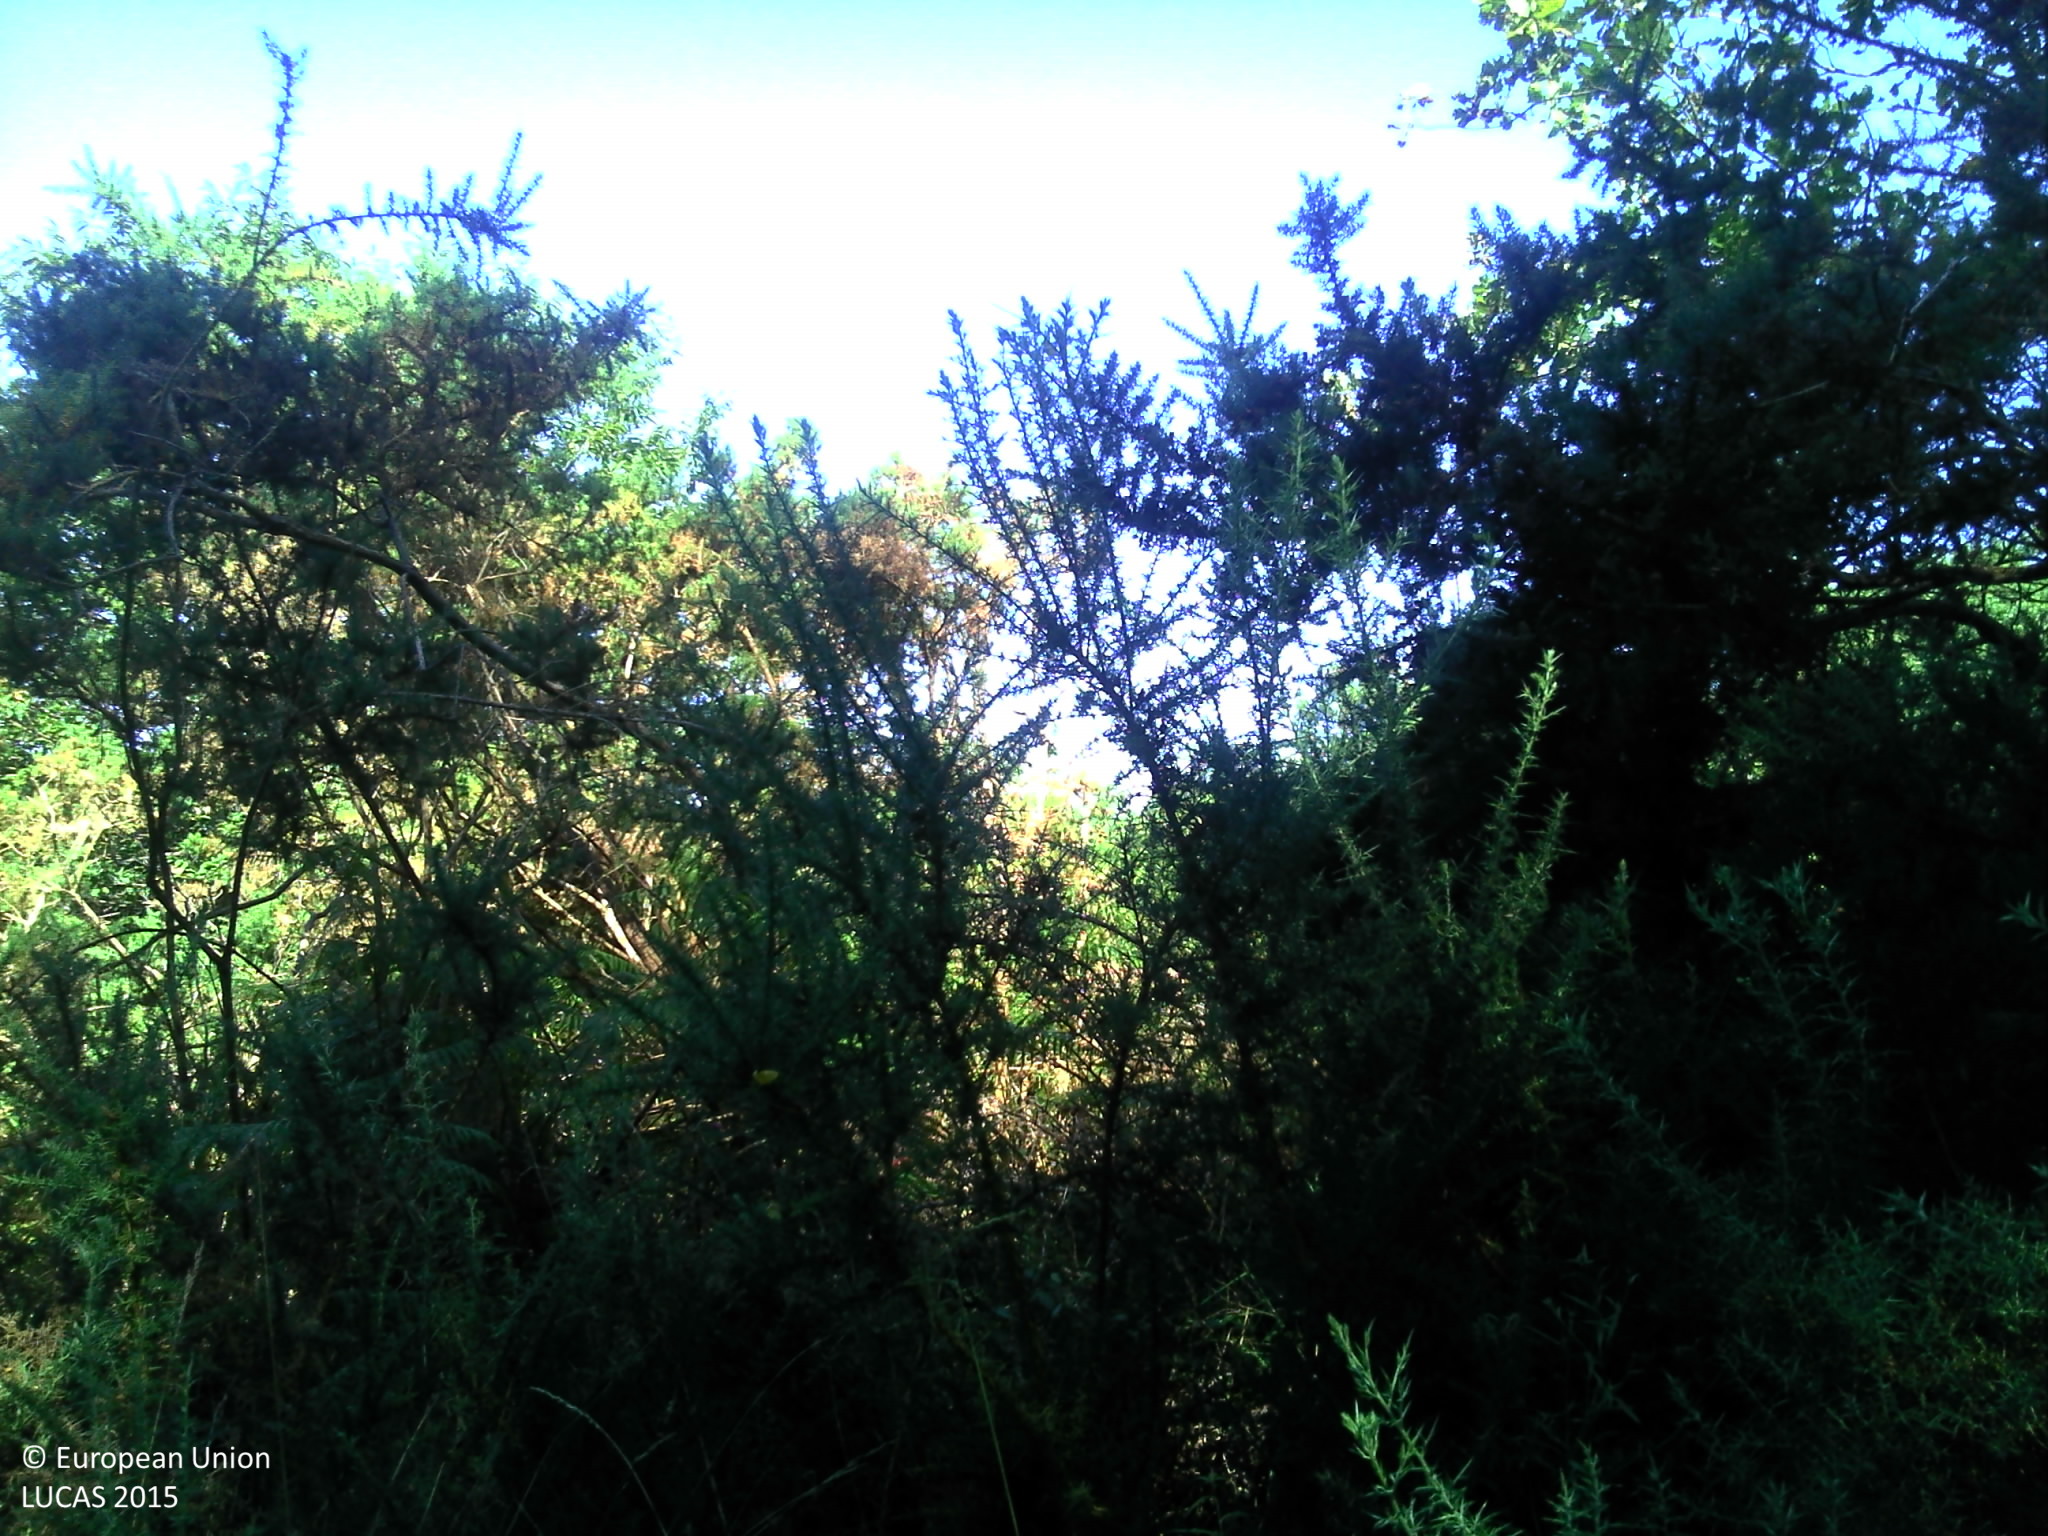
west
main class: Shrubland
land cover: Shrubland with sparse tree cover
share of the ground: > 75 %
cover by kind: shrubs 60 %, herbaceous plants 35 %, broadleaved forest trees 5 %
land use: Semi-natural and natural areas not in use
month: July
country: FR
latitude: 43.5893
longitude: -1.1005
